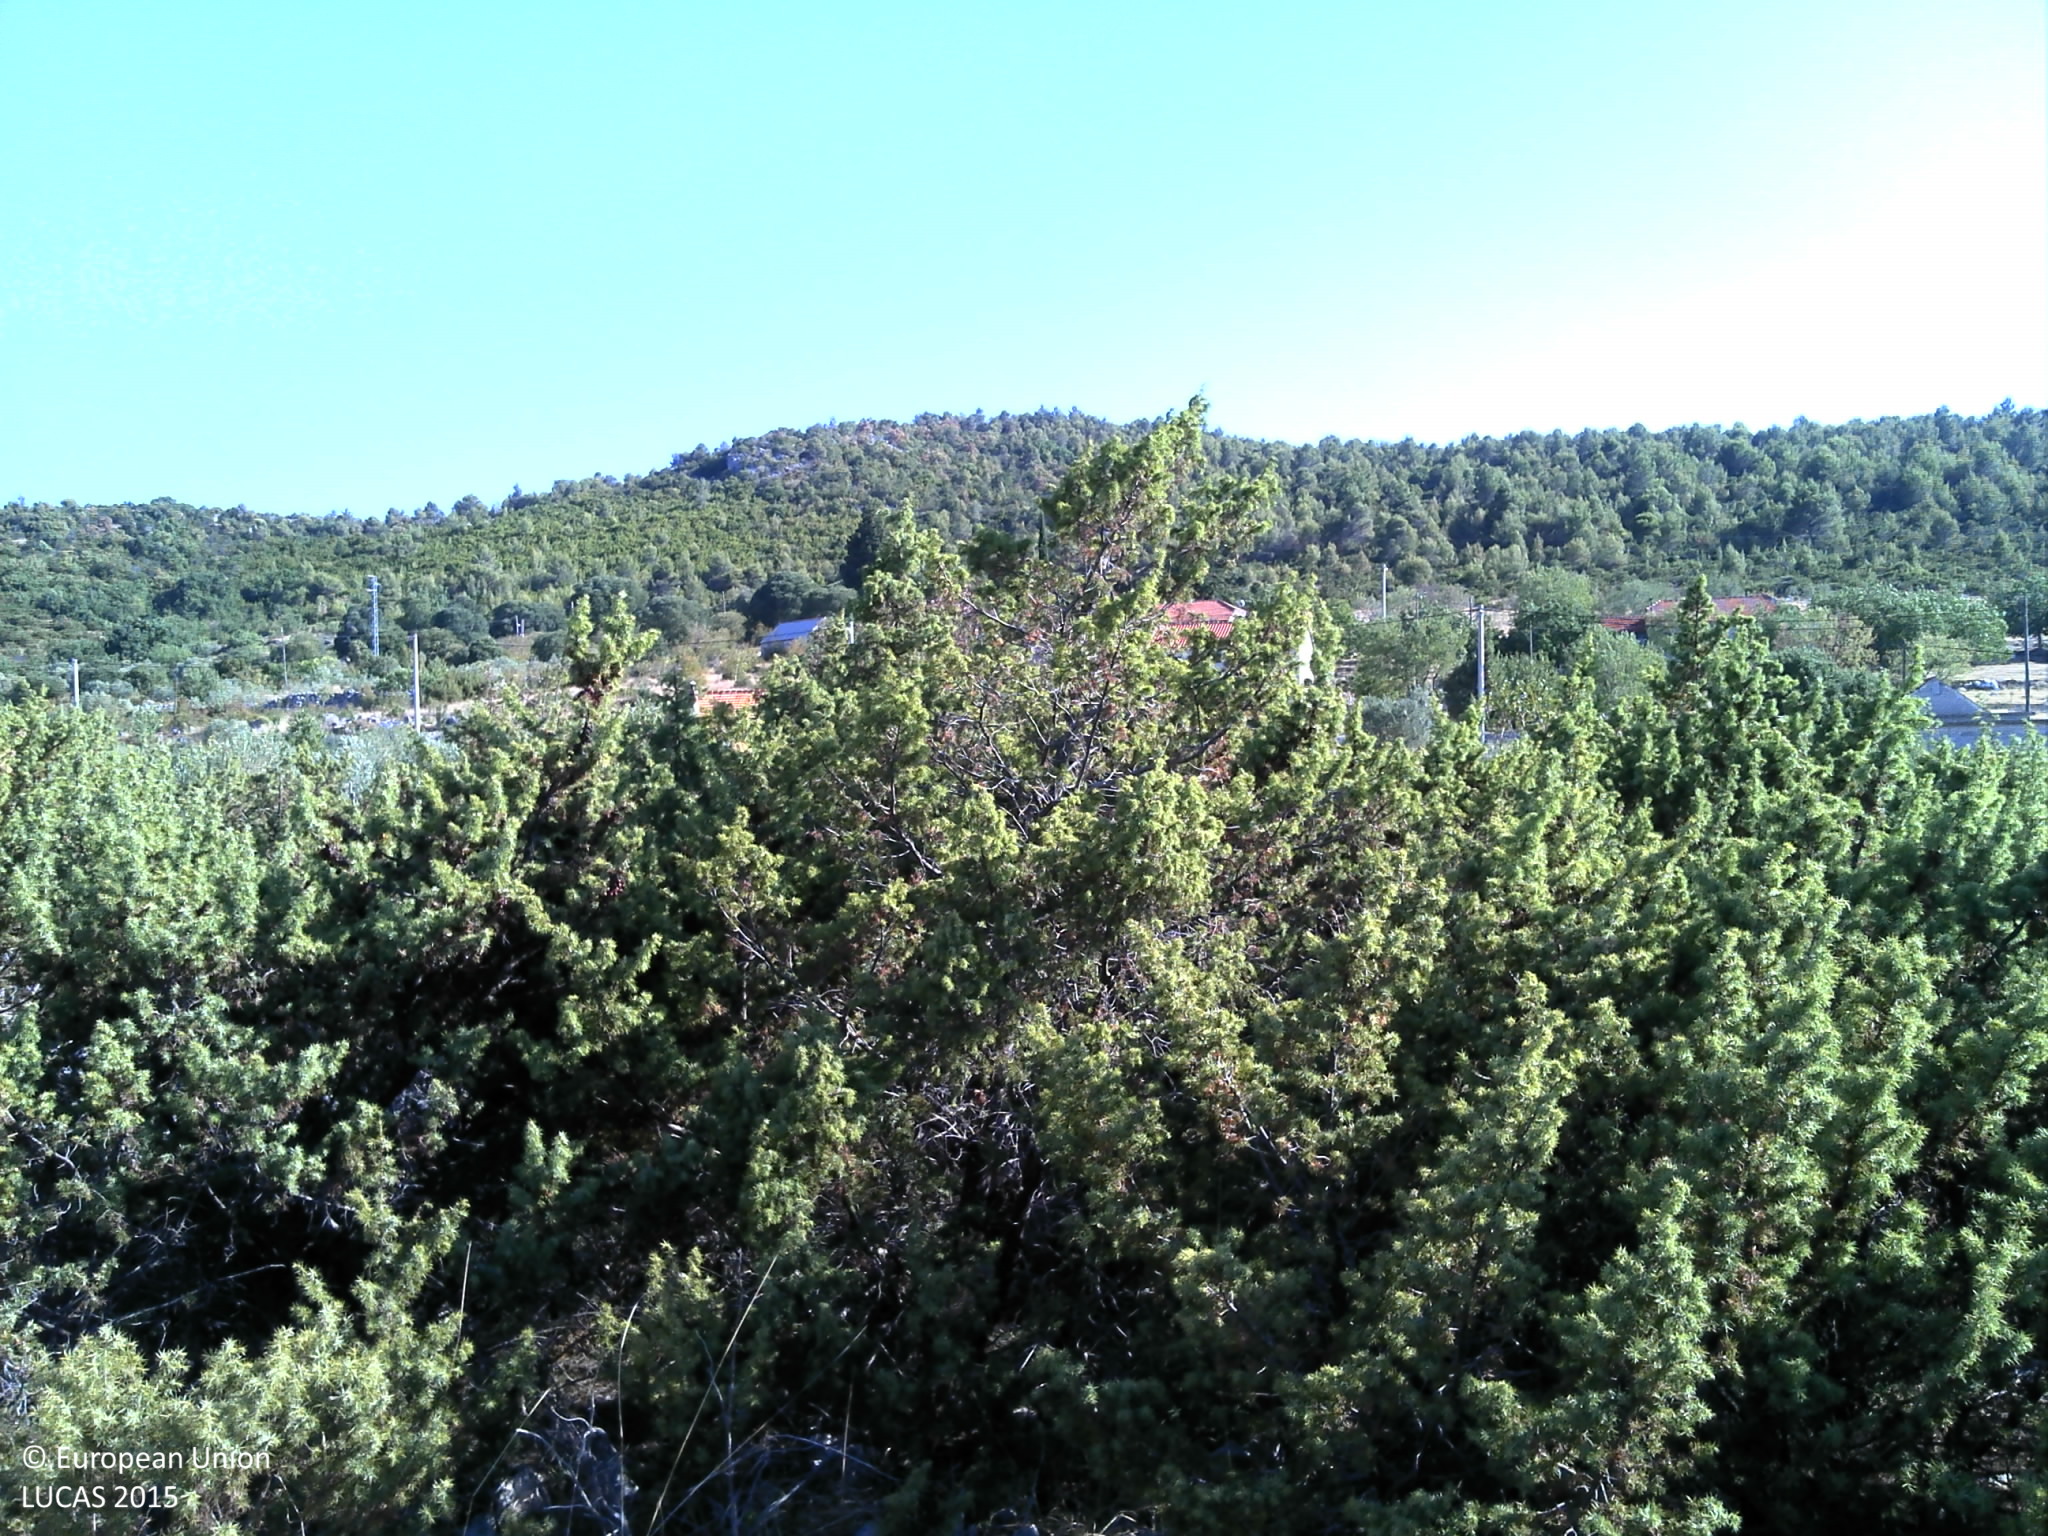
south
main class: Shrubland
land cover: Shrubland without tree cover
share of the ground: 50 - 75 %
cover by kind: shrubs 60 %, herbaceous plants 20 %, consolidated bare surface 10 %, unconsolidated bare surface 10 %
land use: Semi-natural and natural areas not in use
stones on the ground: < 10 %
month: July
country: HR
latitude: 43.6673
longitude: 16.0554
